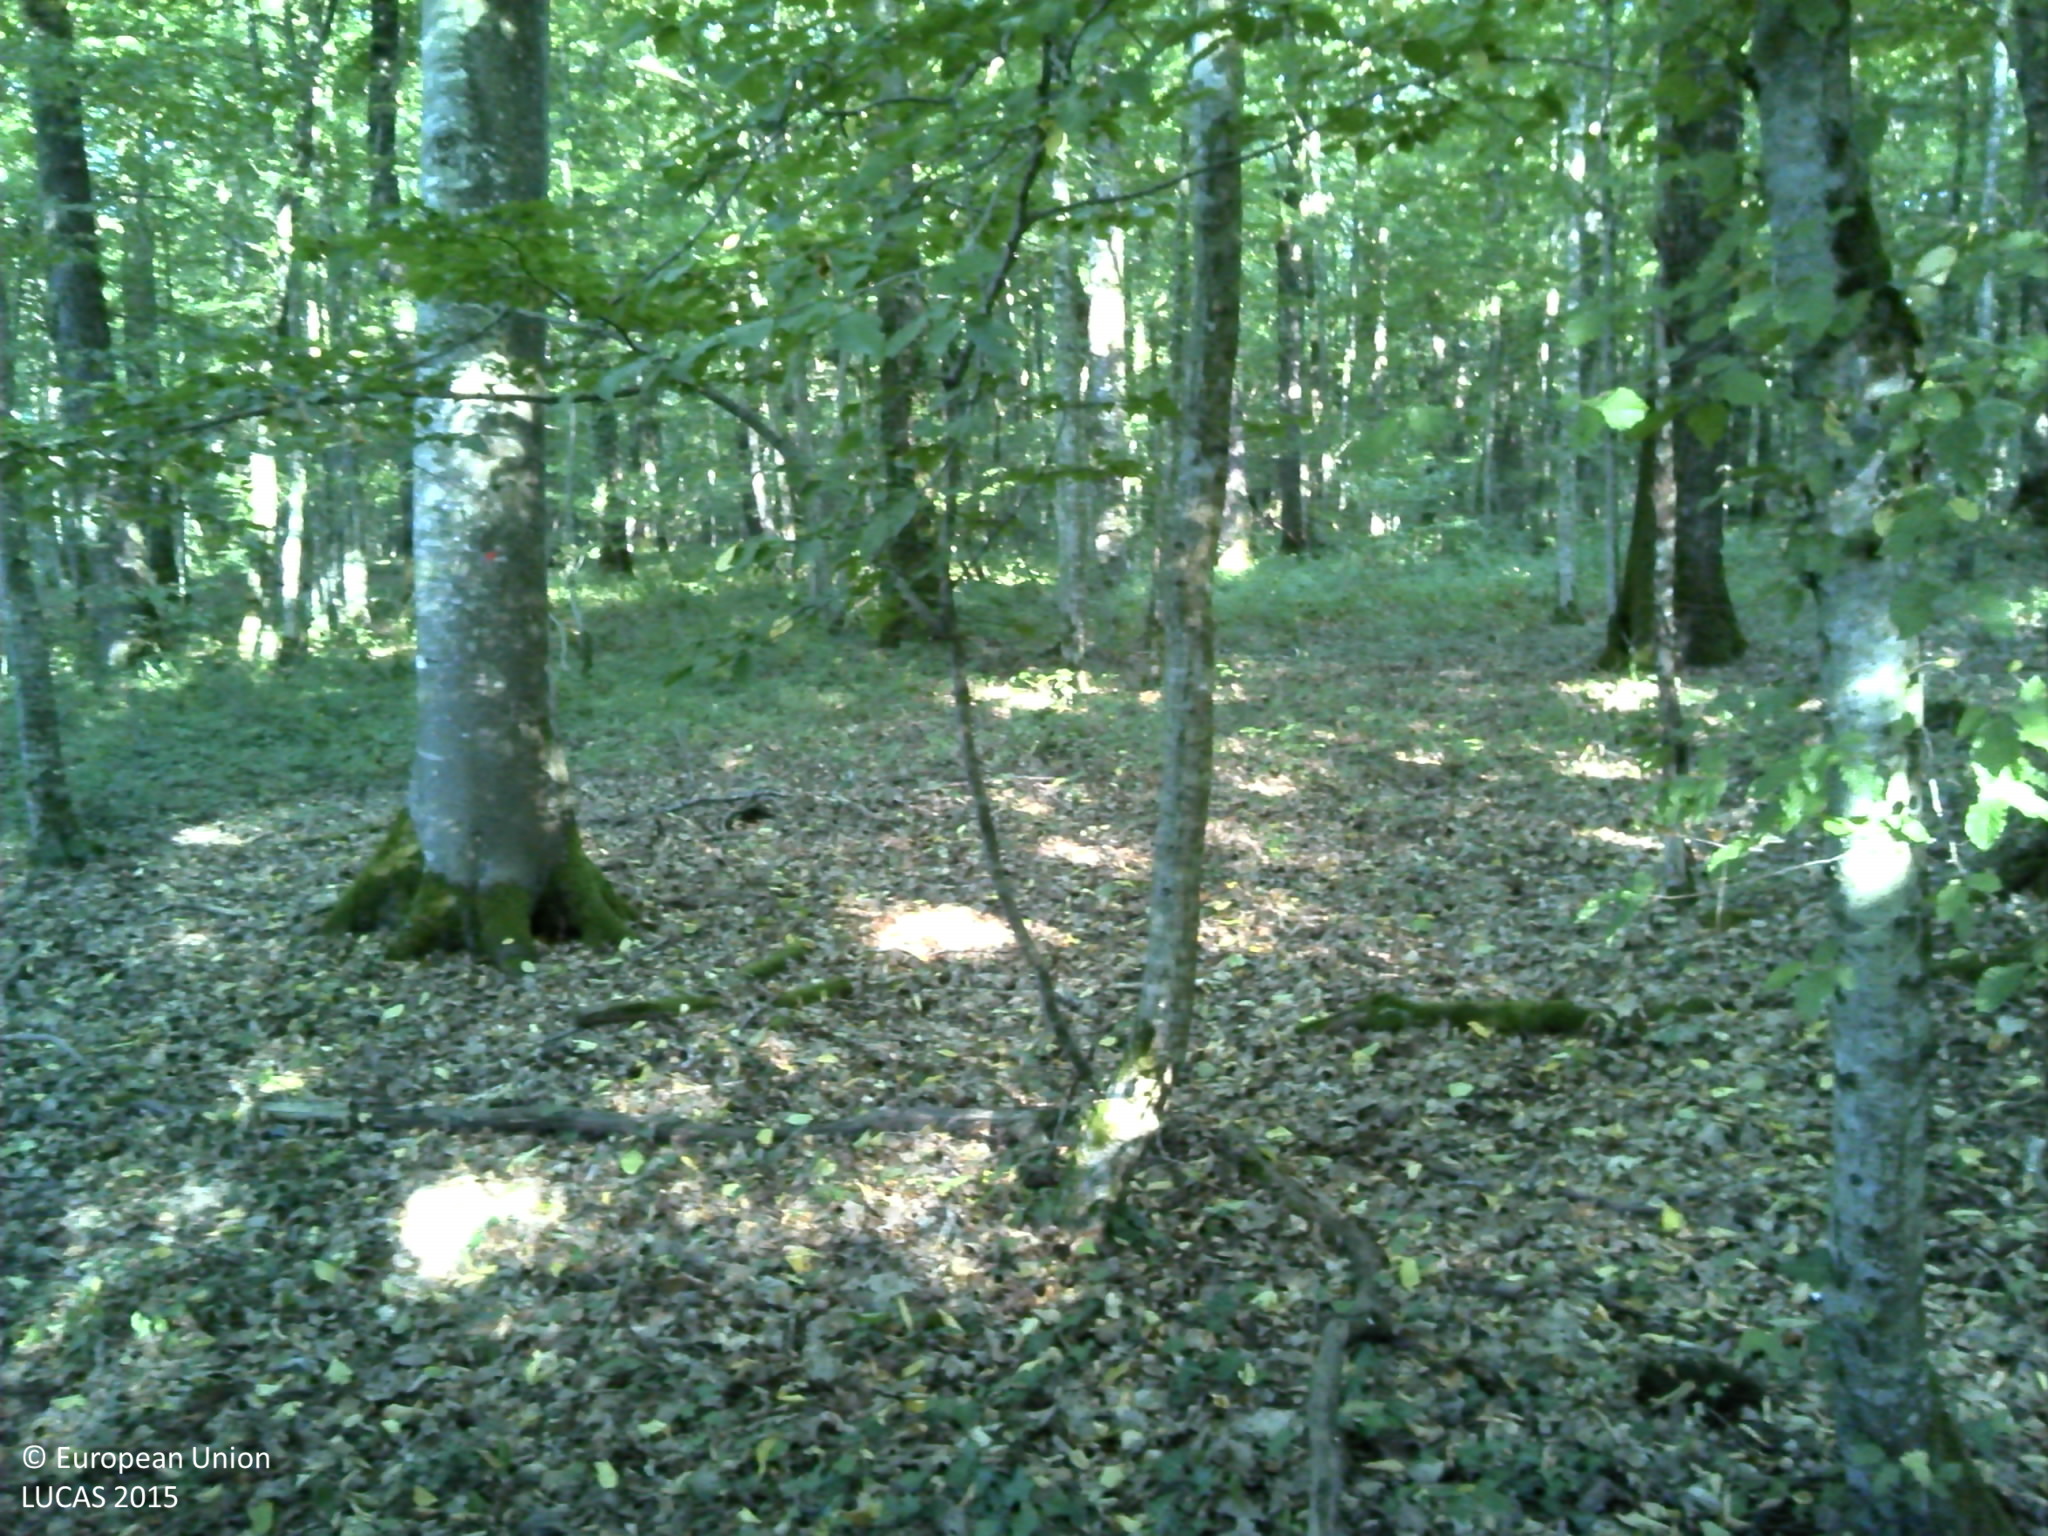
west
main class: Woodland
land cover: Broadleaved woodland
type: mountainous beech forest
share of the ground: > 75 %
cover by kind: broadleaved forest trees 100 %
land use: Forestry
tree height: > 5 m
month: July
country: FR
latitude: 48.2970
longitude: 6.0506
